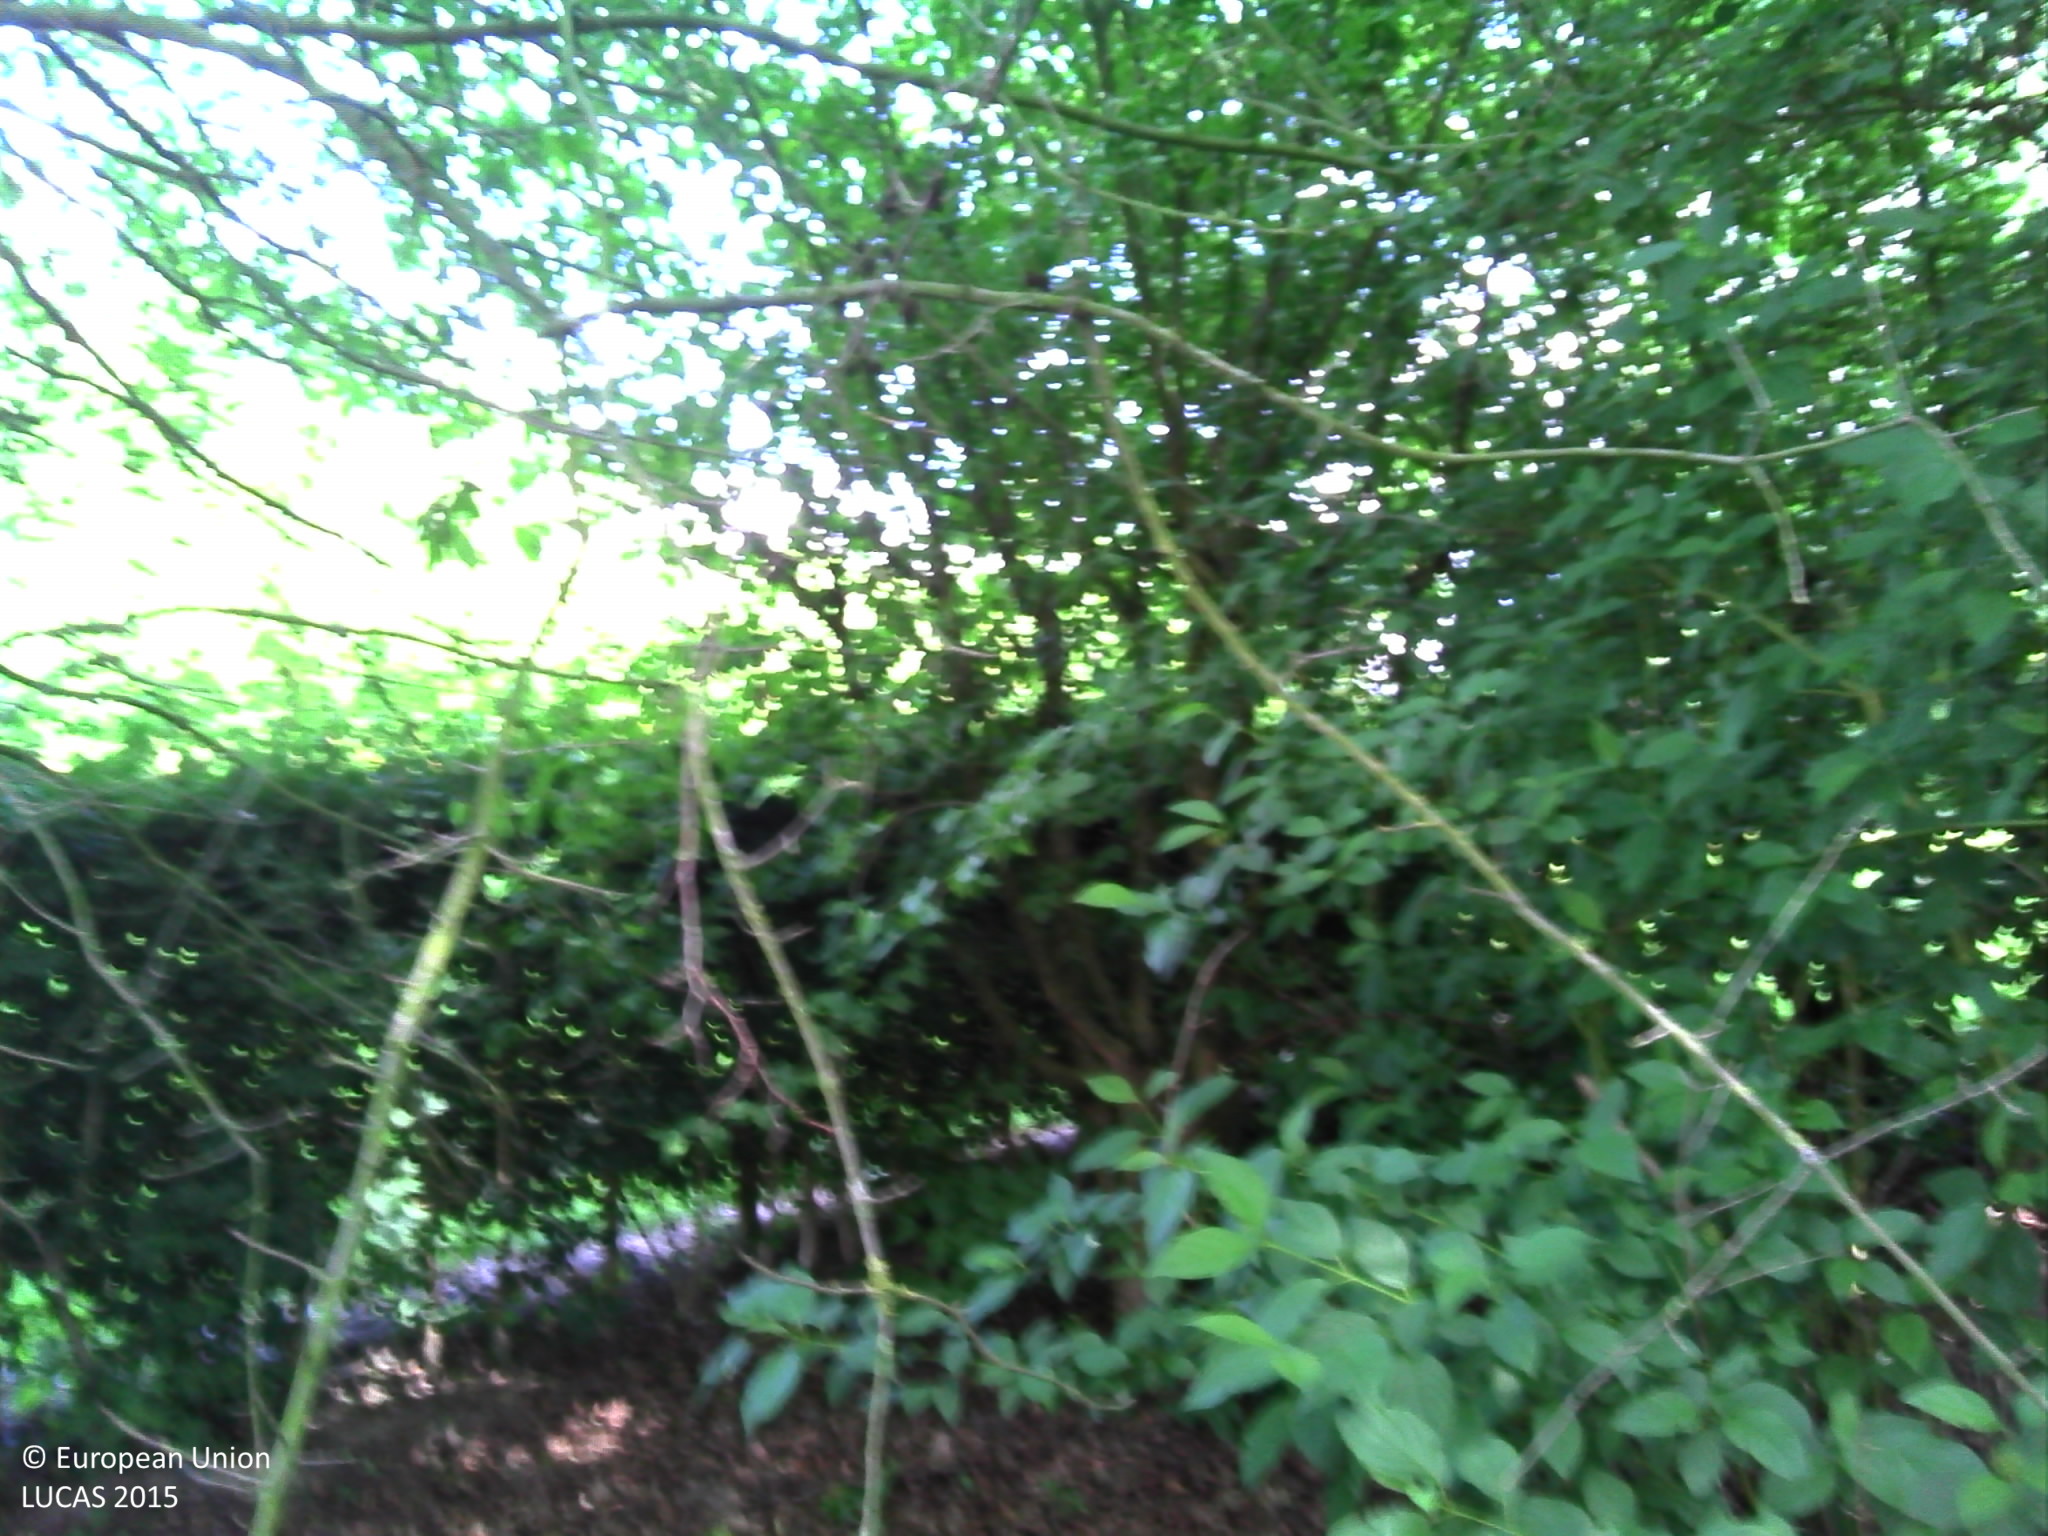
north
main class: Woodland
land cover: Broadleaved woodland
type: mesophytic deciduous forest
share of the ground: > 75 %
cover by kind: broadleaved forest trees 100 %
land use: Residential
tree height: > 5 m
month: June
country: BE
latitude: 50.8935
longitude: 3.6948
